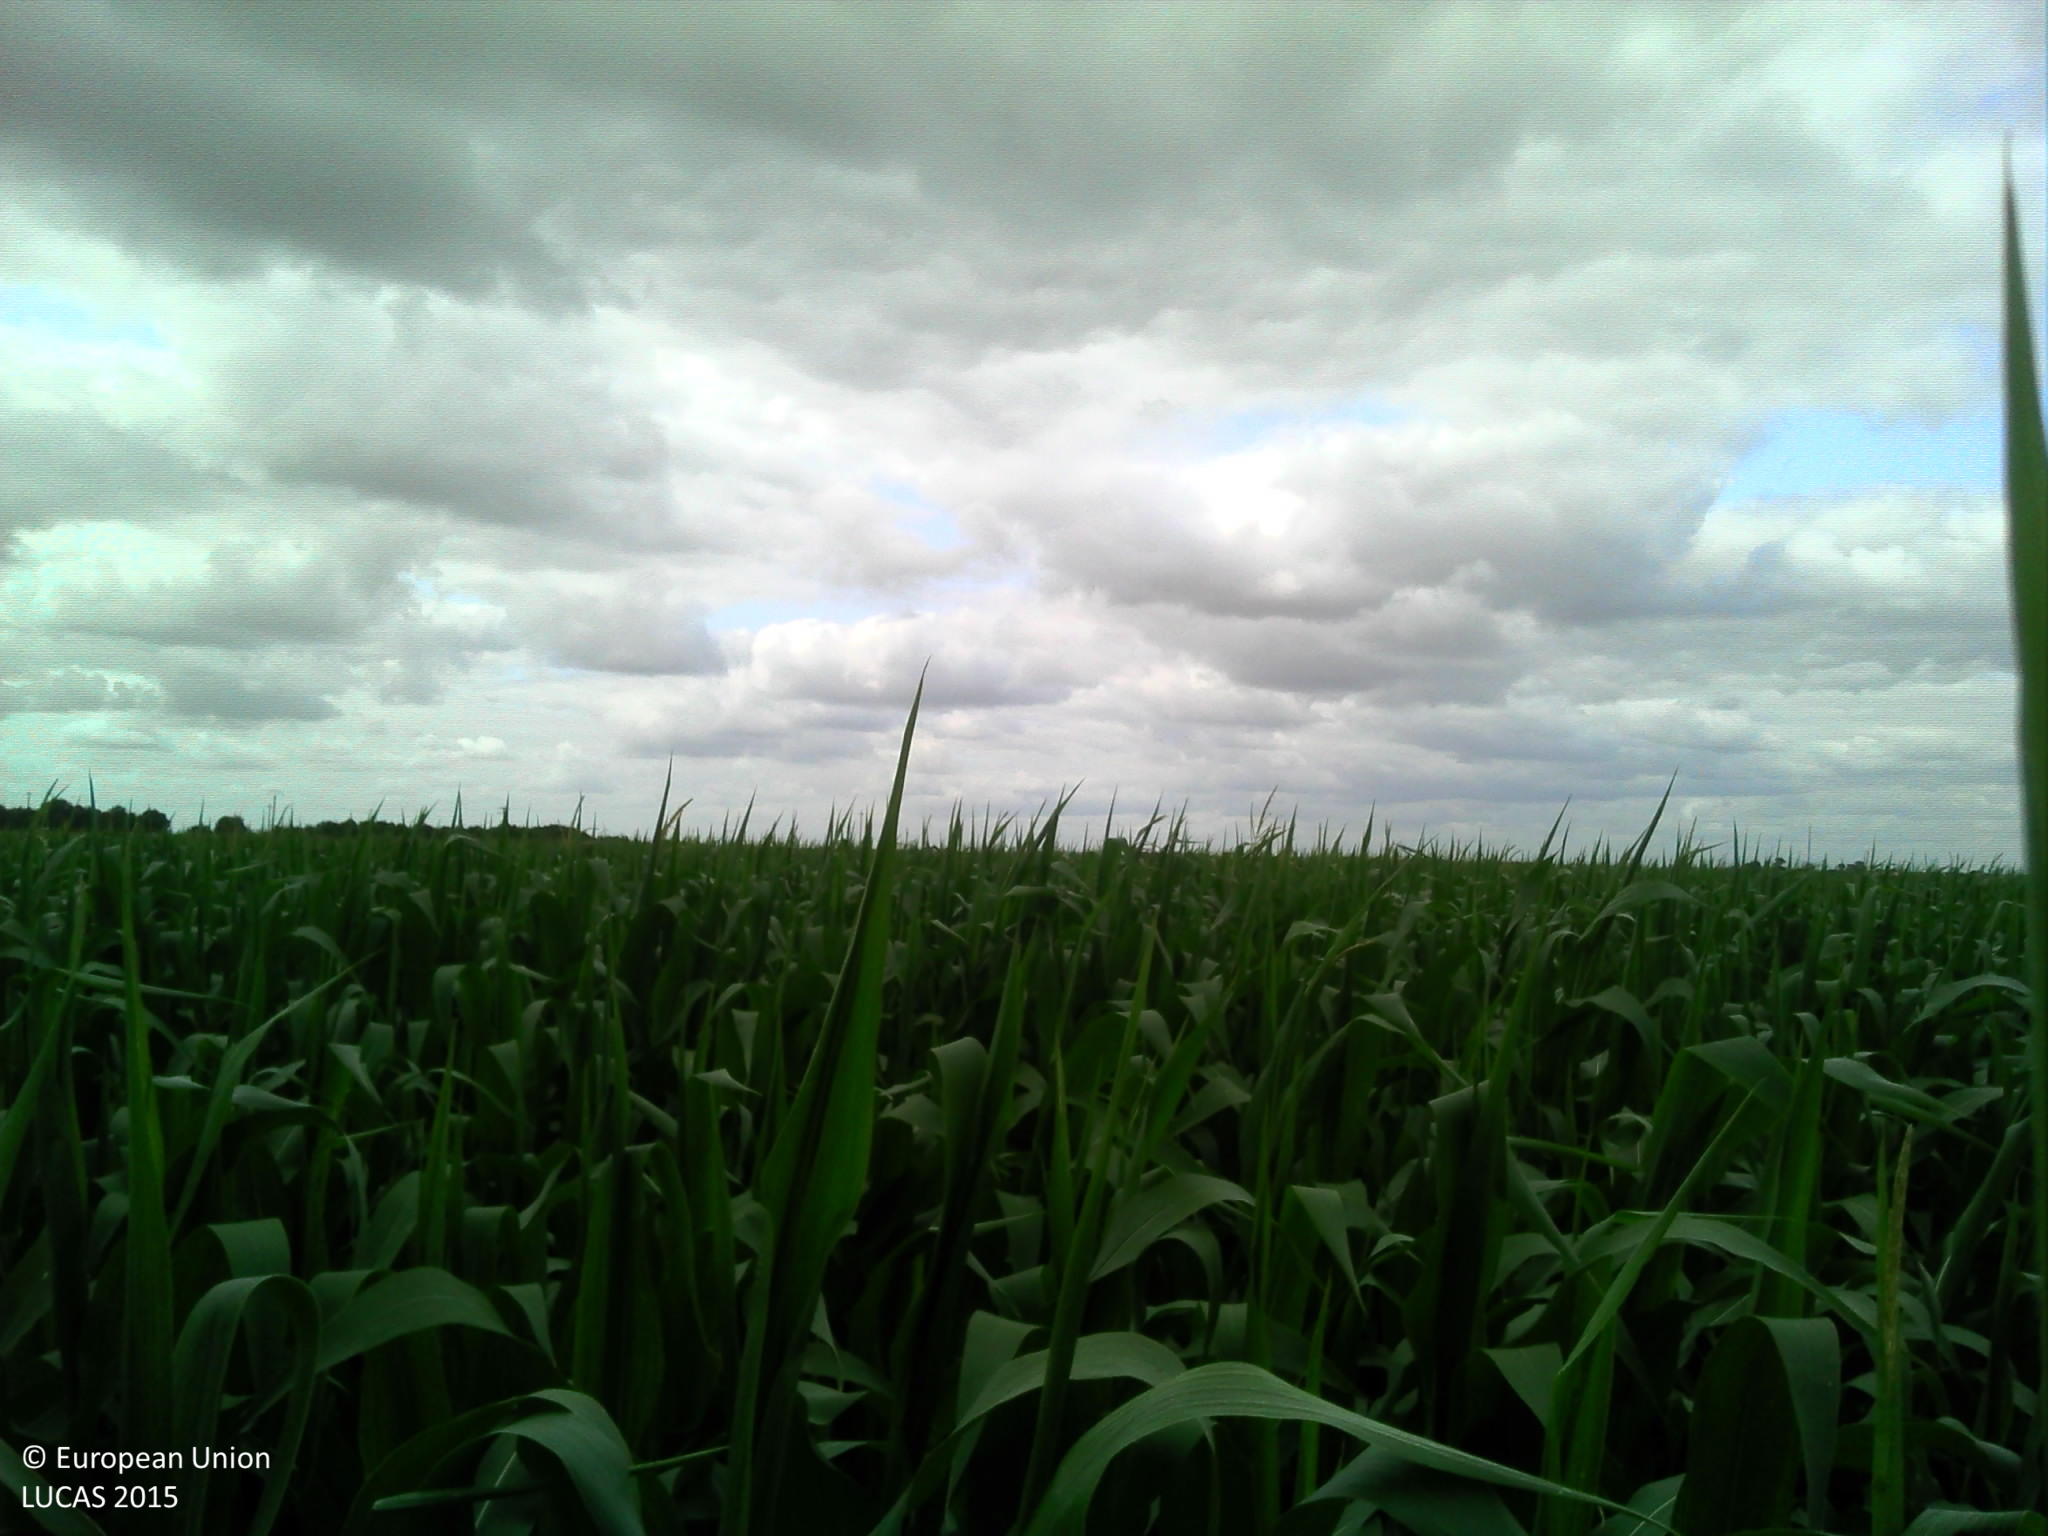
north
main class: Cropland
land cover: Maize
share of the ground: > 75 %
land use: Agriculture (excluding fallow land and kitchen gardens)
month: July
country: FR
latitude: 46.3624
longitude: -1.3562
